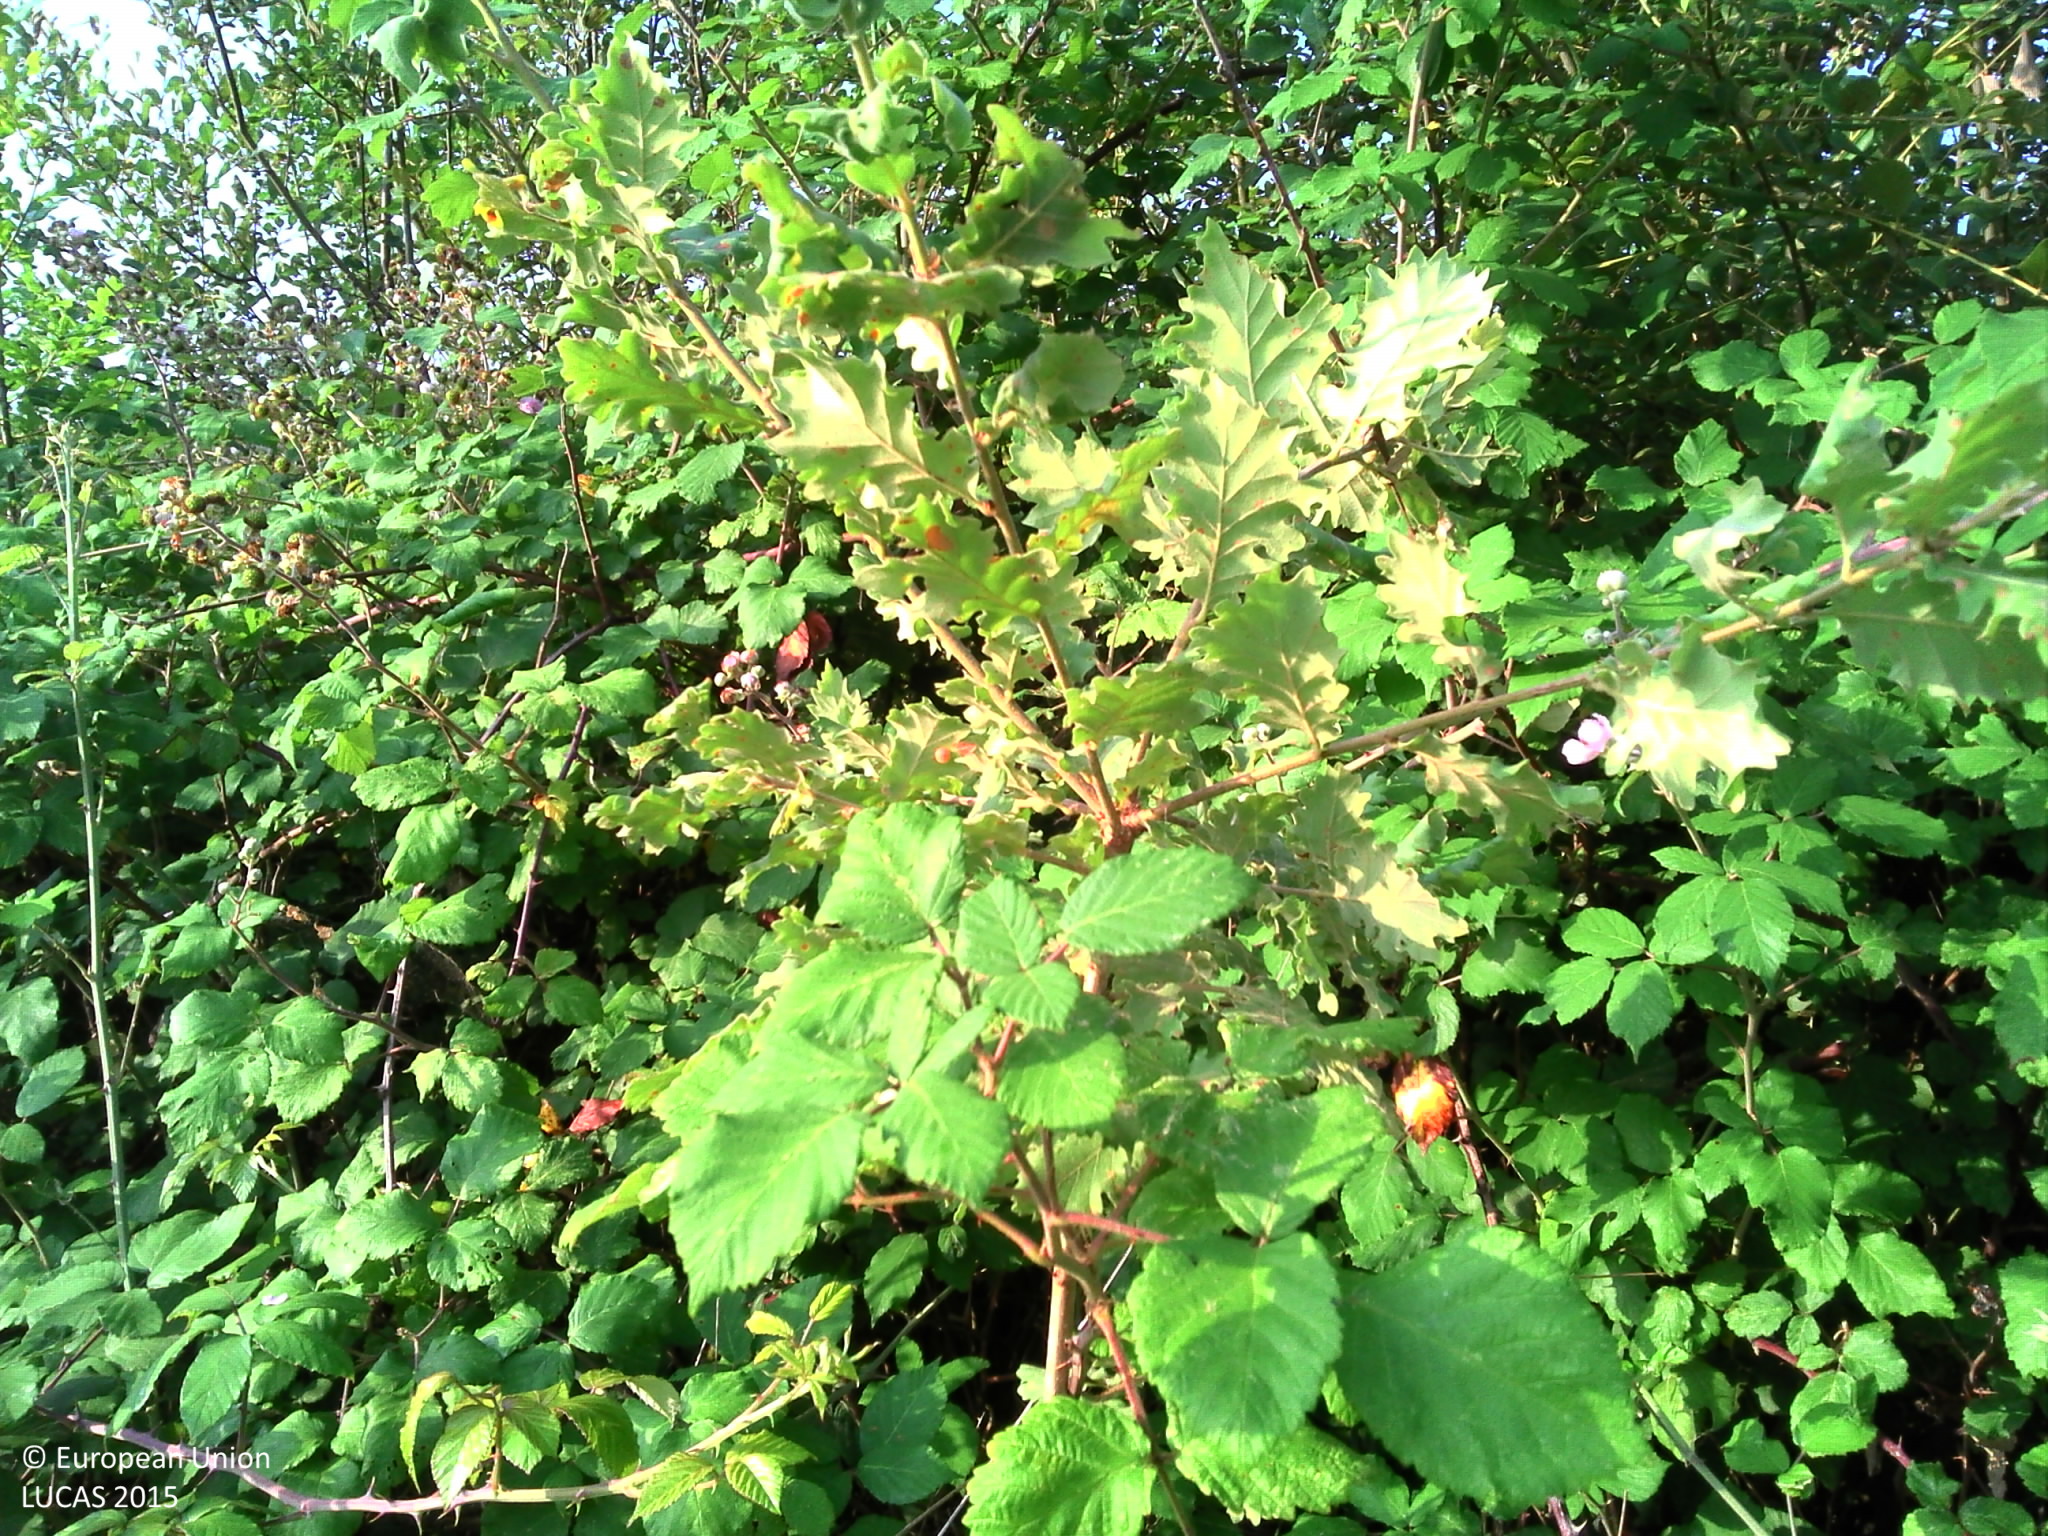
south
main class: Grassland
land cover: Spontaneously vegetated surfaces
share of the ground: > 75 %
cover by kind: herbaceous plants 100 %
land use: Semi-natural and natural areas not in use
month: July
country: FR
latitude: 43.1343
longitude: 1.1155
